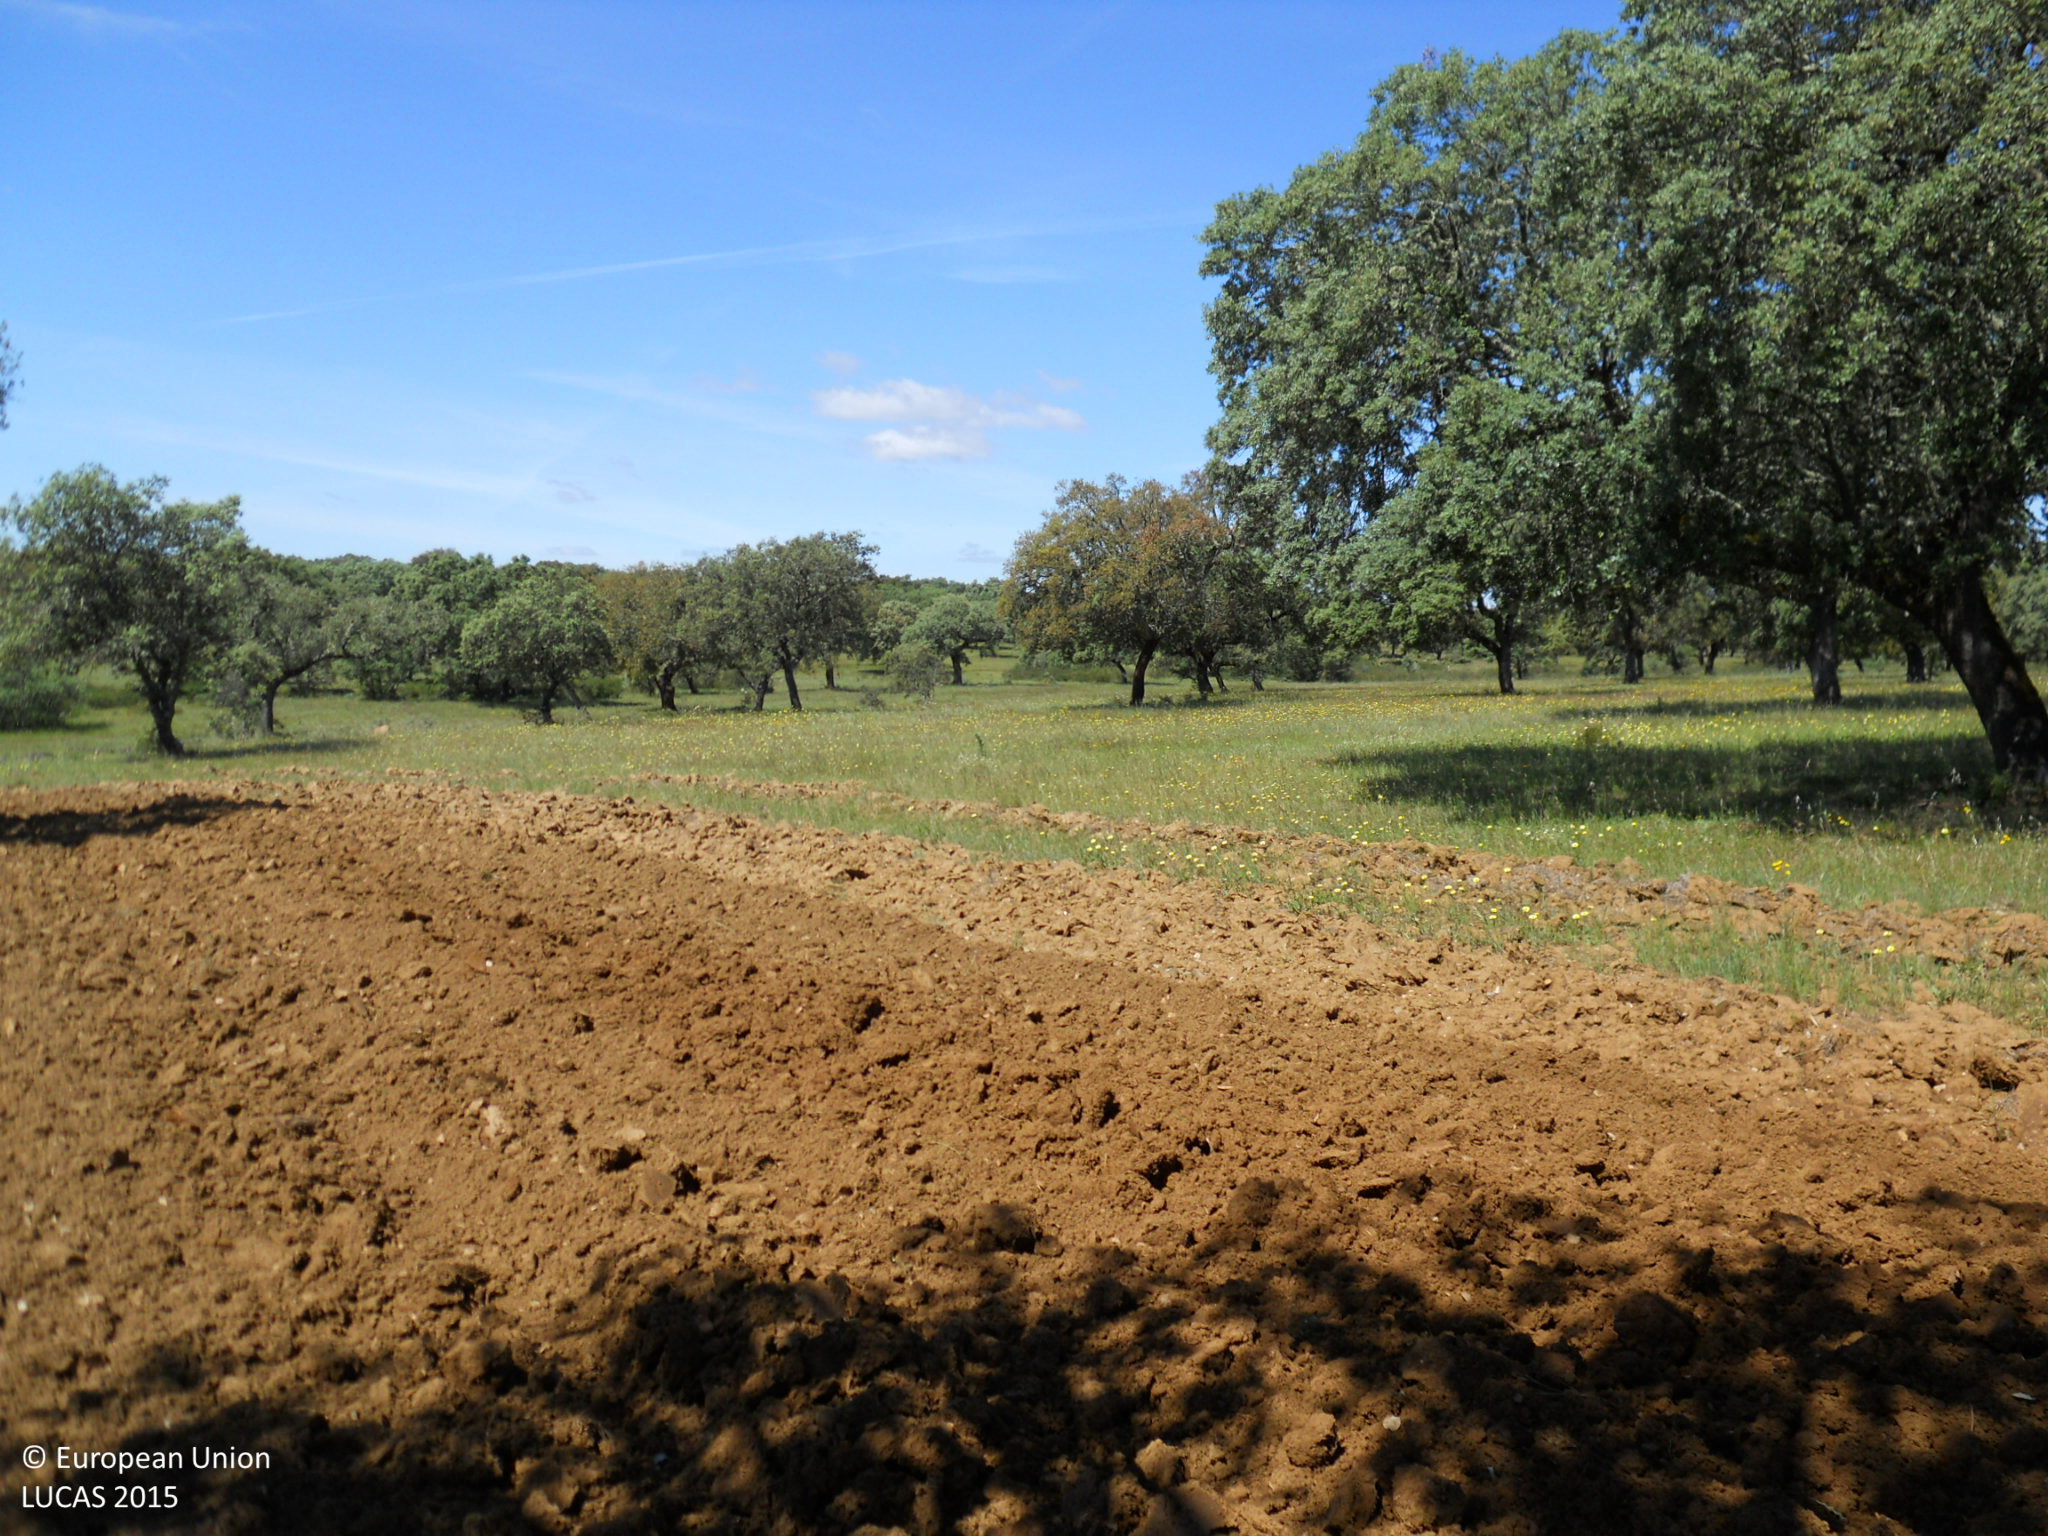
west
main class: Woodland
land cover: Broadleaved woodland
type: broadleaved evergreen forest
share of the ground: > 75 %
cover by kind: broadleaved forest trees 90 %, herbaceous plants 5 %, unconsolidated bare surface 5 %
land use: Forestry
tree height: > 5 m
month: April
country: ES
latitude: 39.1623
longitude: -6.7708
